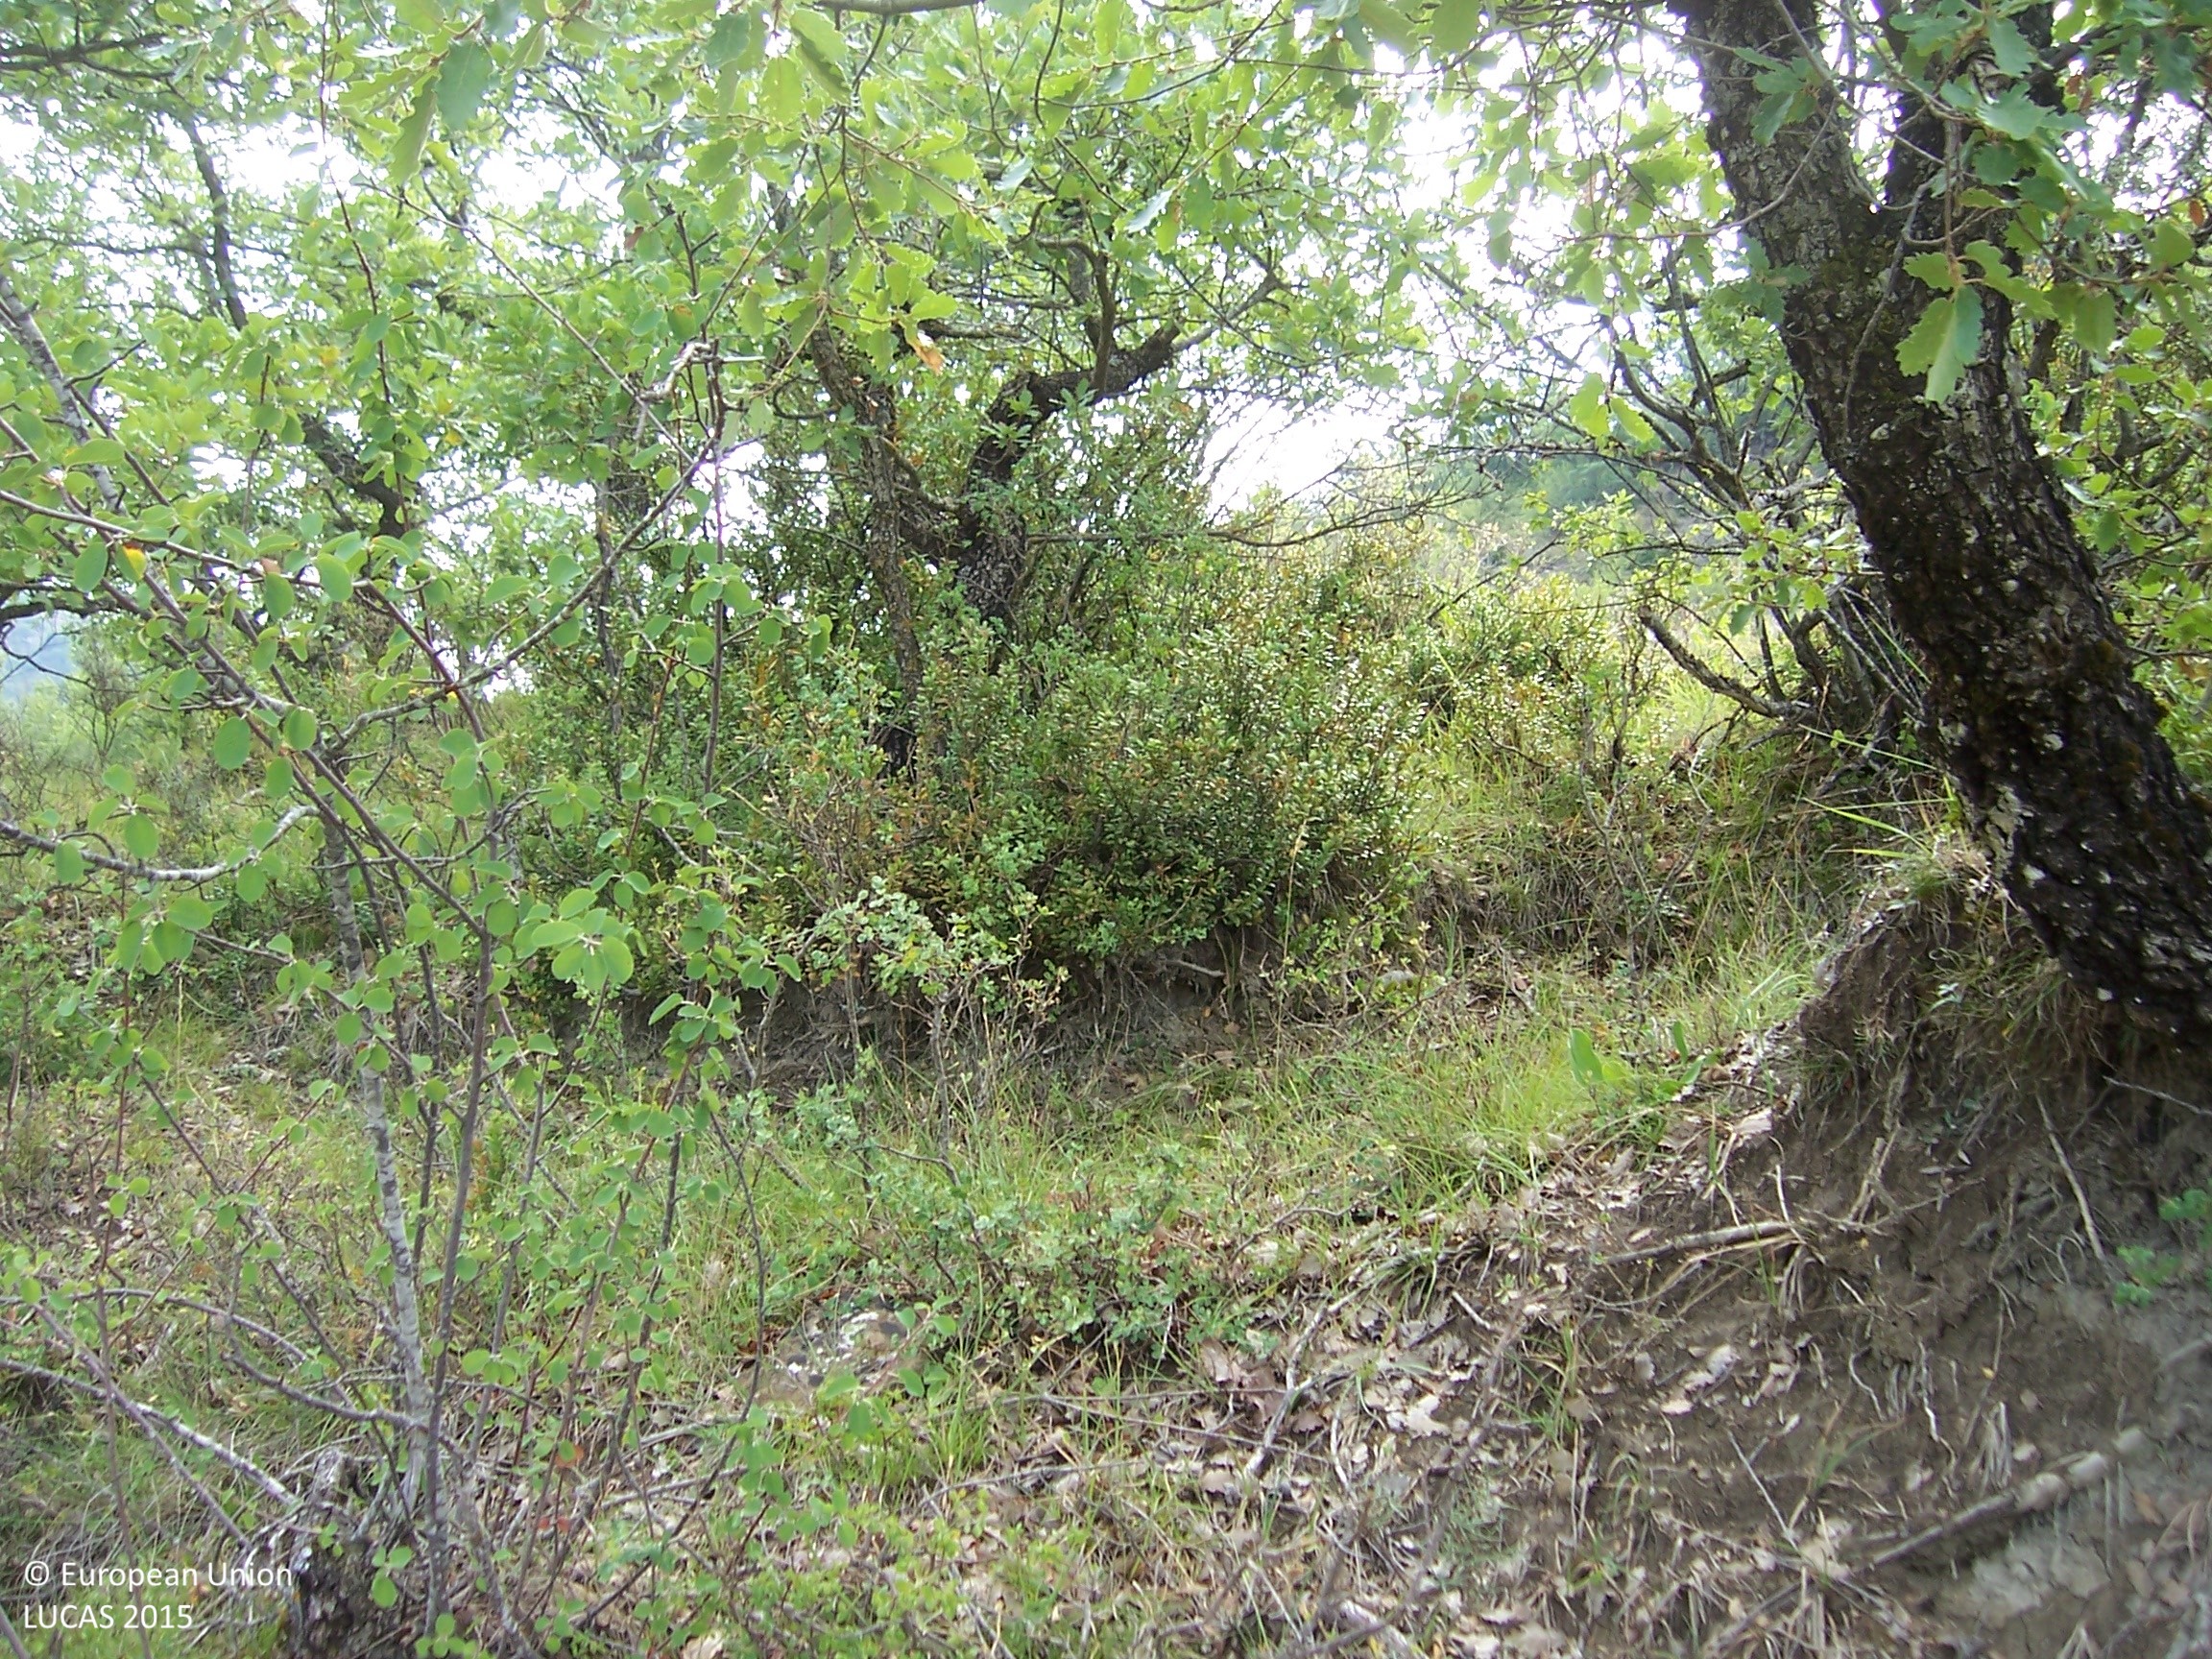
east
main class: Woodland
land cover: Broadleaved woodland
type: acidophilous oak and oak-birch forest
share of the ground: > 75 %
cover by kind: consolidated bare surface 60 %, broadleaved forest trees 30 %, shrubs 10 %
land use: Semi-natural and natural areas not in use
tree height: > 5 m
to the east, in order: Broadleaved woodland; Other bare soil; Shrubland without tree cover; Broadleaved woodland; Shrubland with sparse tree cover; Broadleaved woodland
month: August
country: ES
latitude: 42.5573
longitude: -0.3662
